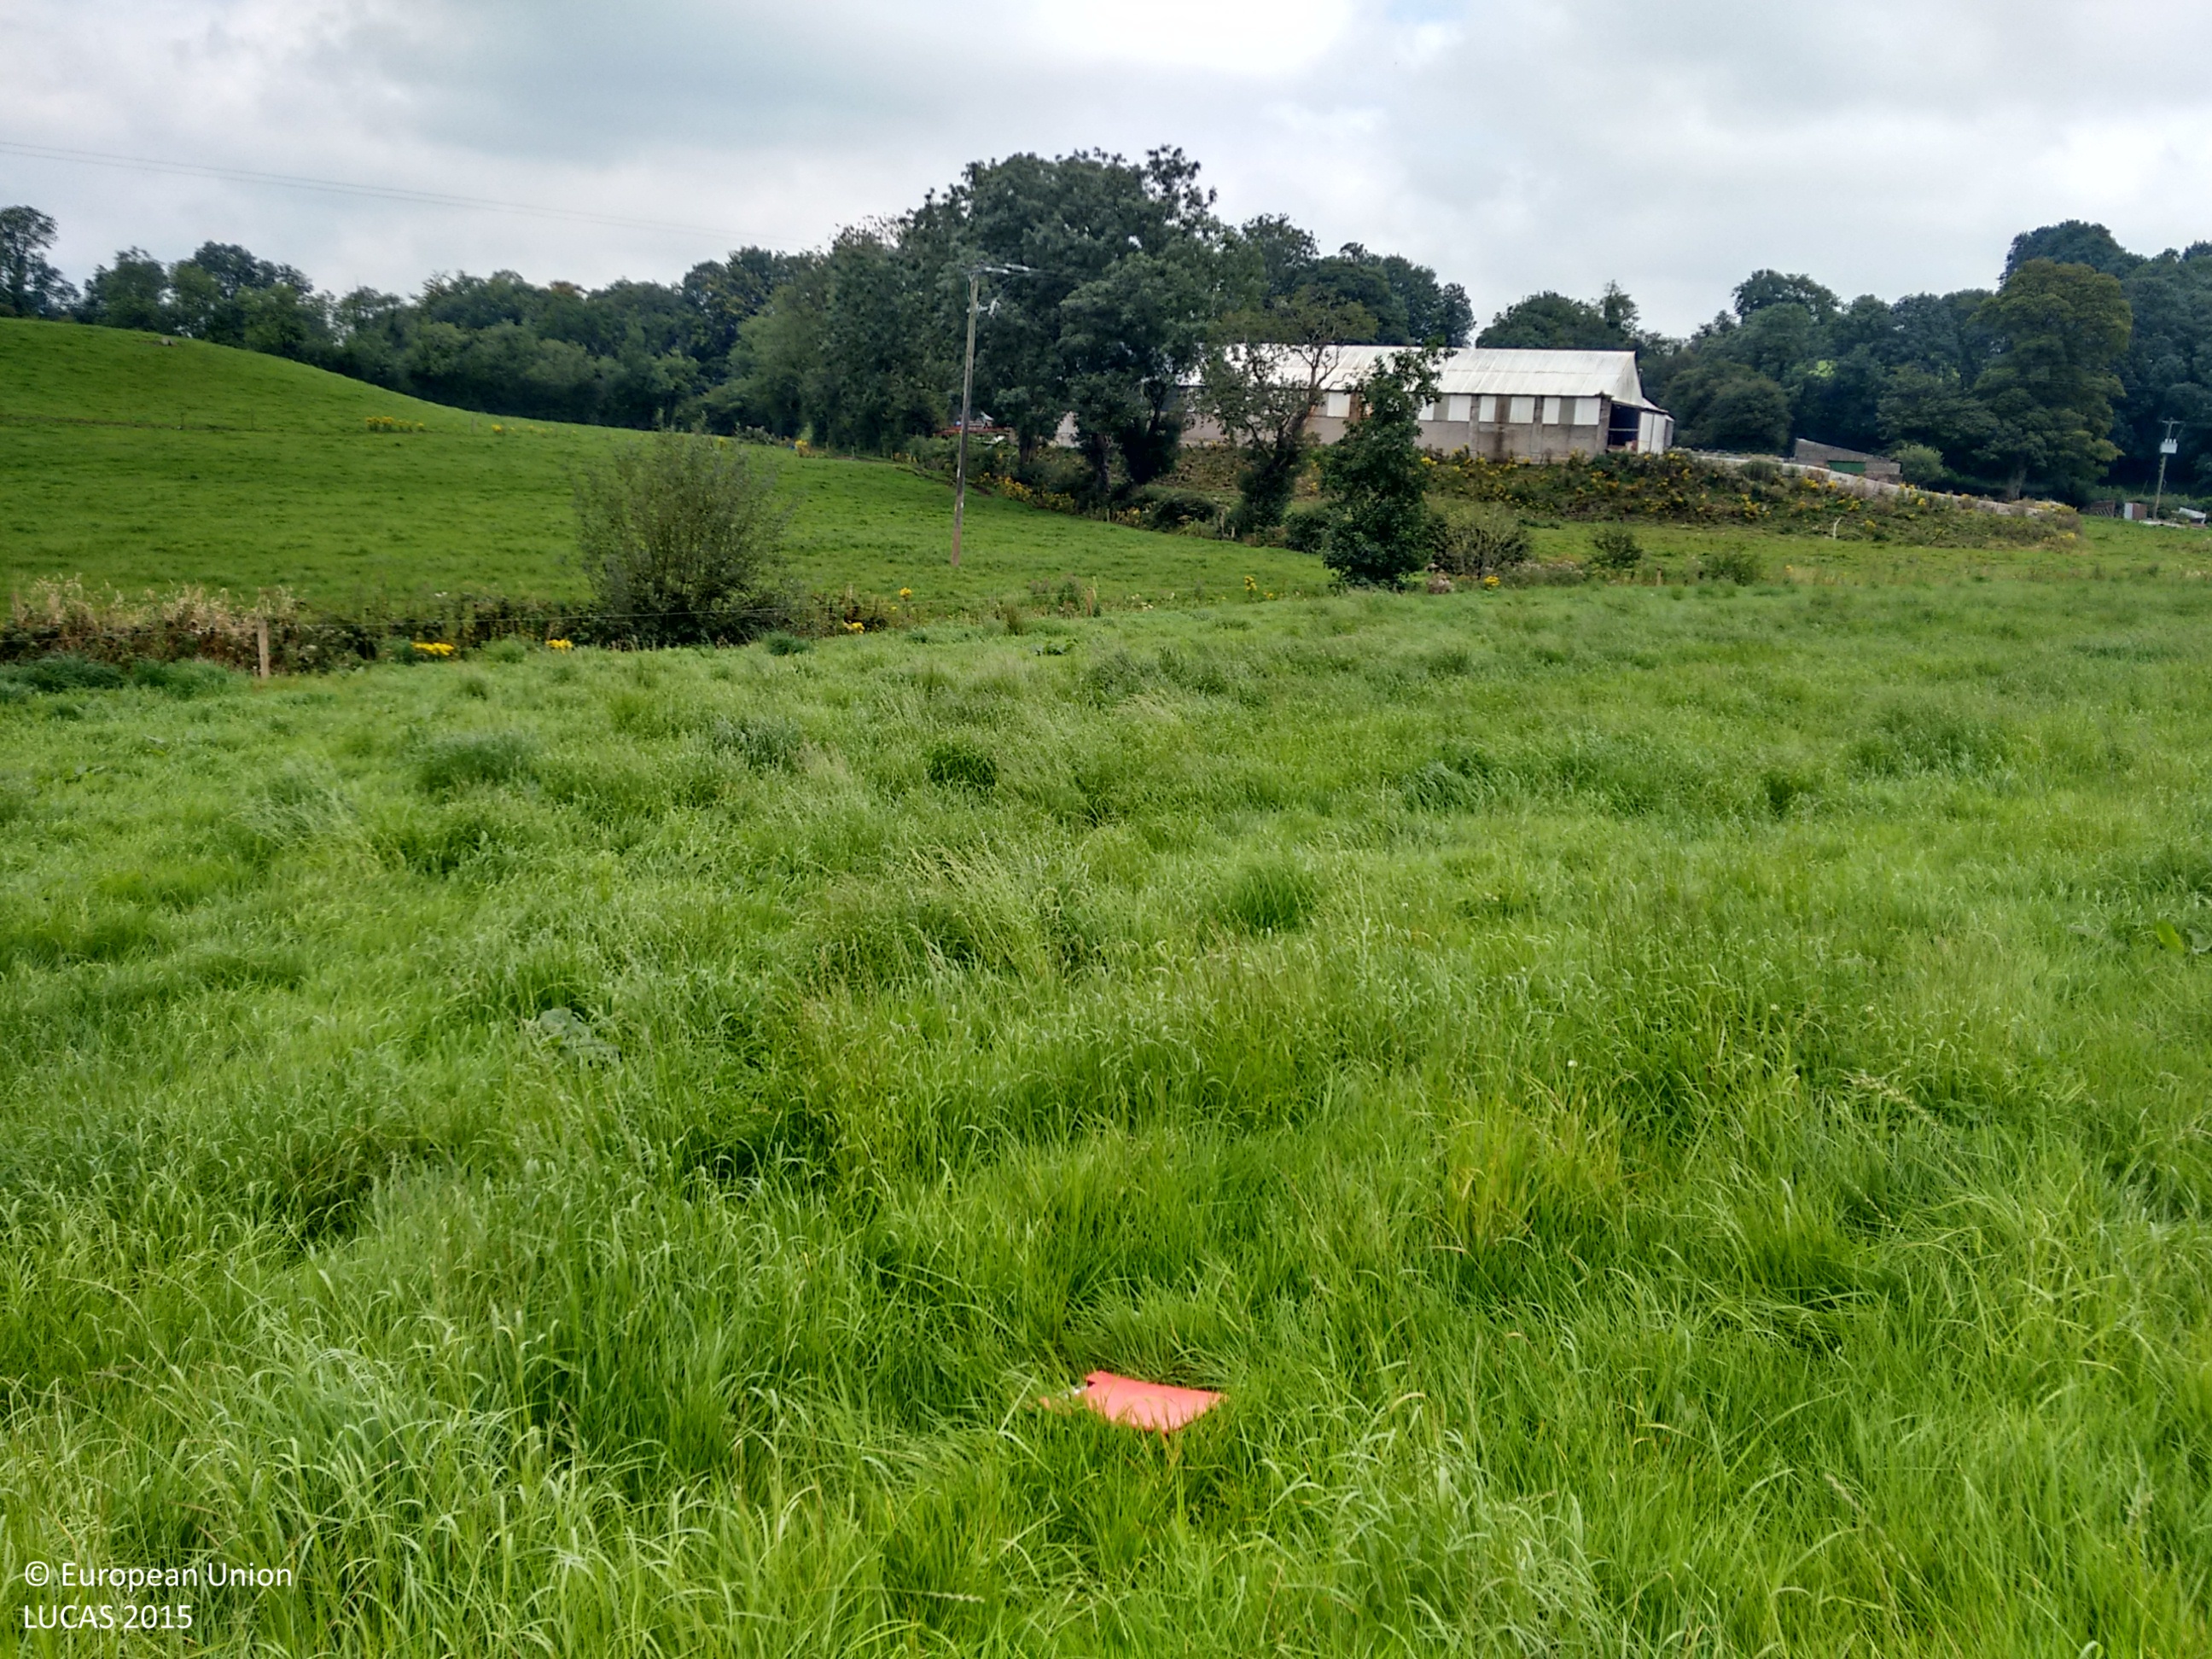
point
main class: Grassland
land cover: Grassland without tree/shrub cover
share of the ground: > 75 %
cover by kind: herbaceous plants 100 %
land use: Agriculture (excluding fallow land and kitchen gardens)
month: September
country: IE
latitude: 54.2738
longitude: -7.0811
